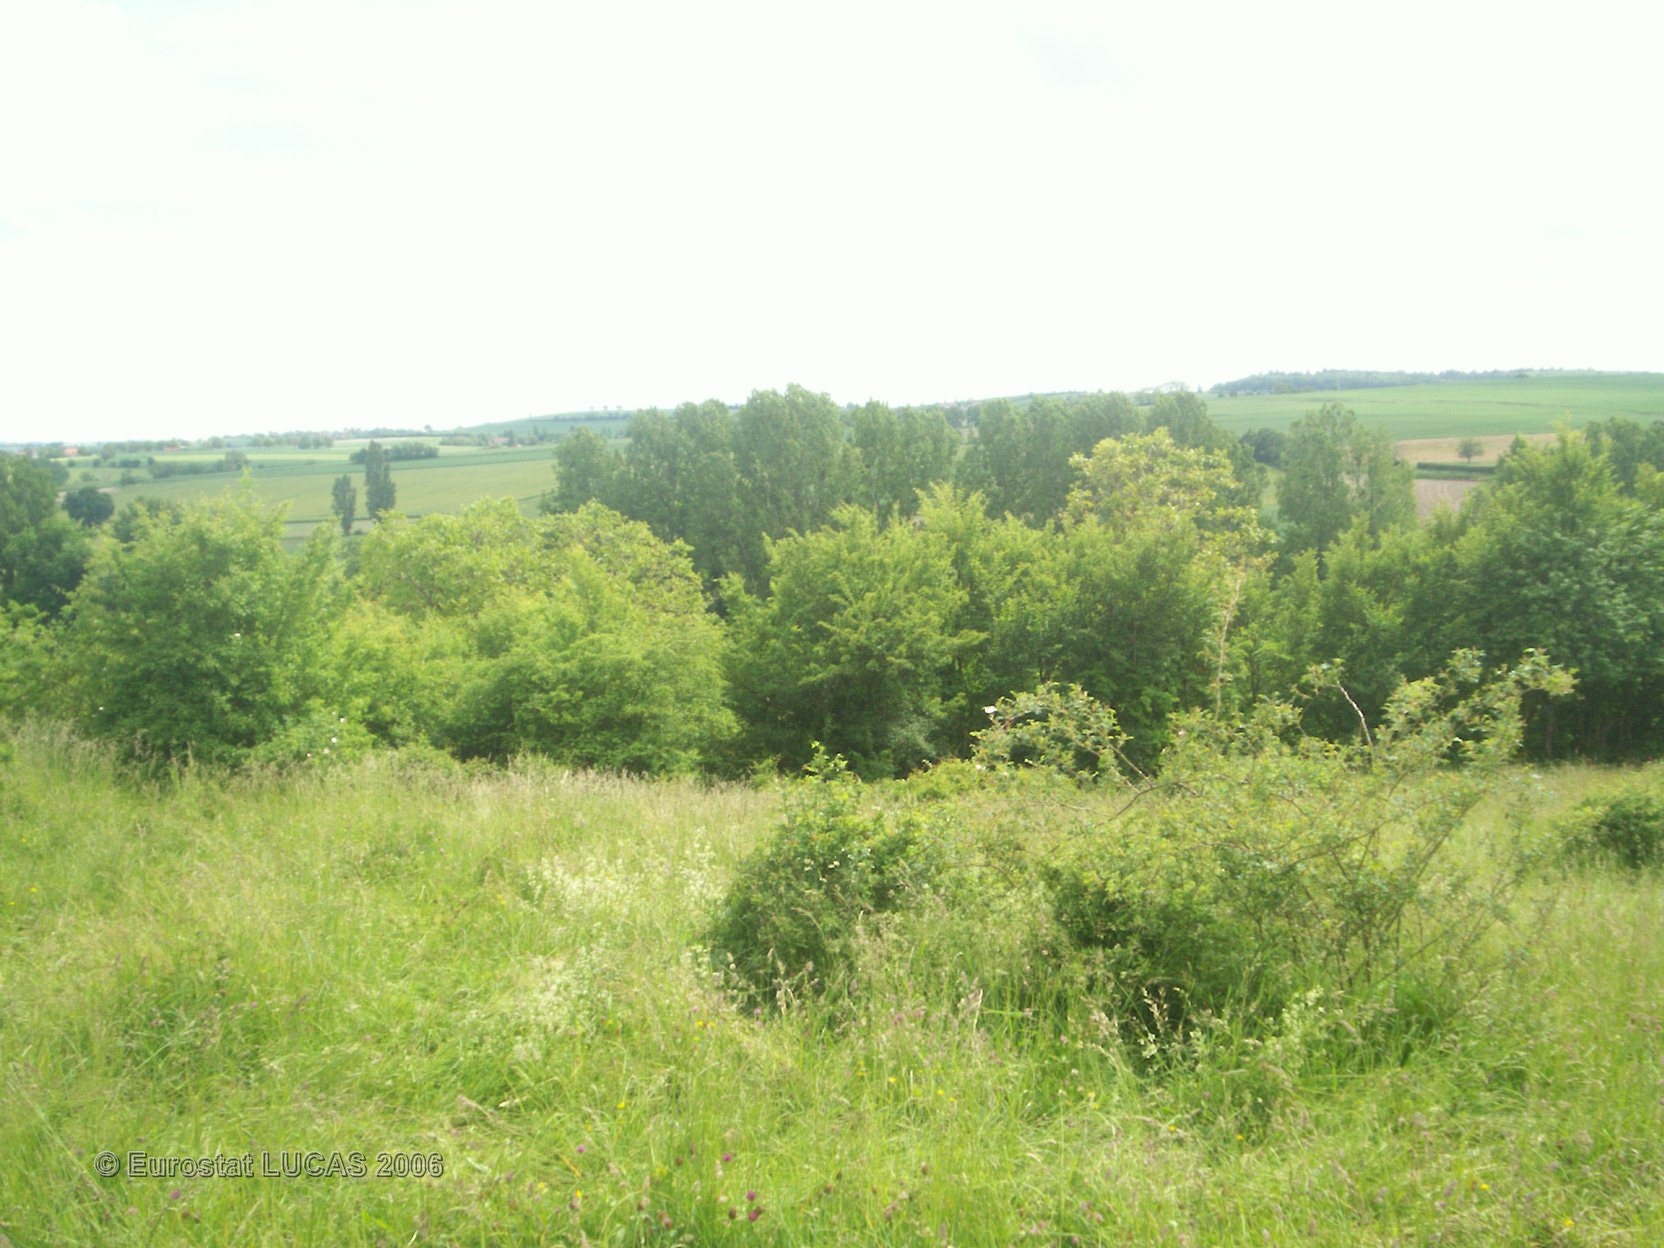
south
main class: Grassland
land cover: Grassland with sparse tree/shrub cover
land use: Agriculture (excluding fallow land and kitchen gardens)
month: May
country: FR
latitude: 46.1625
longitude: 3.0700
